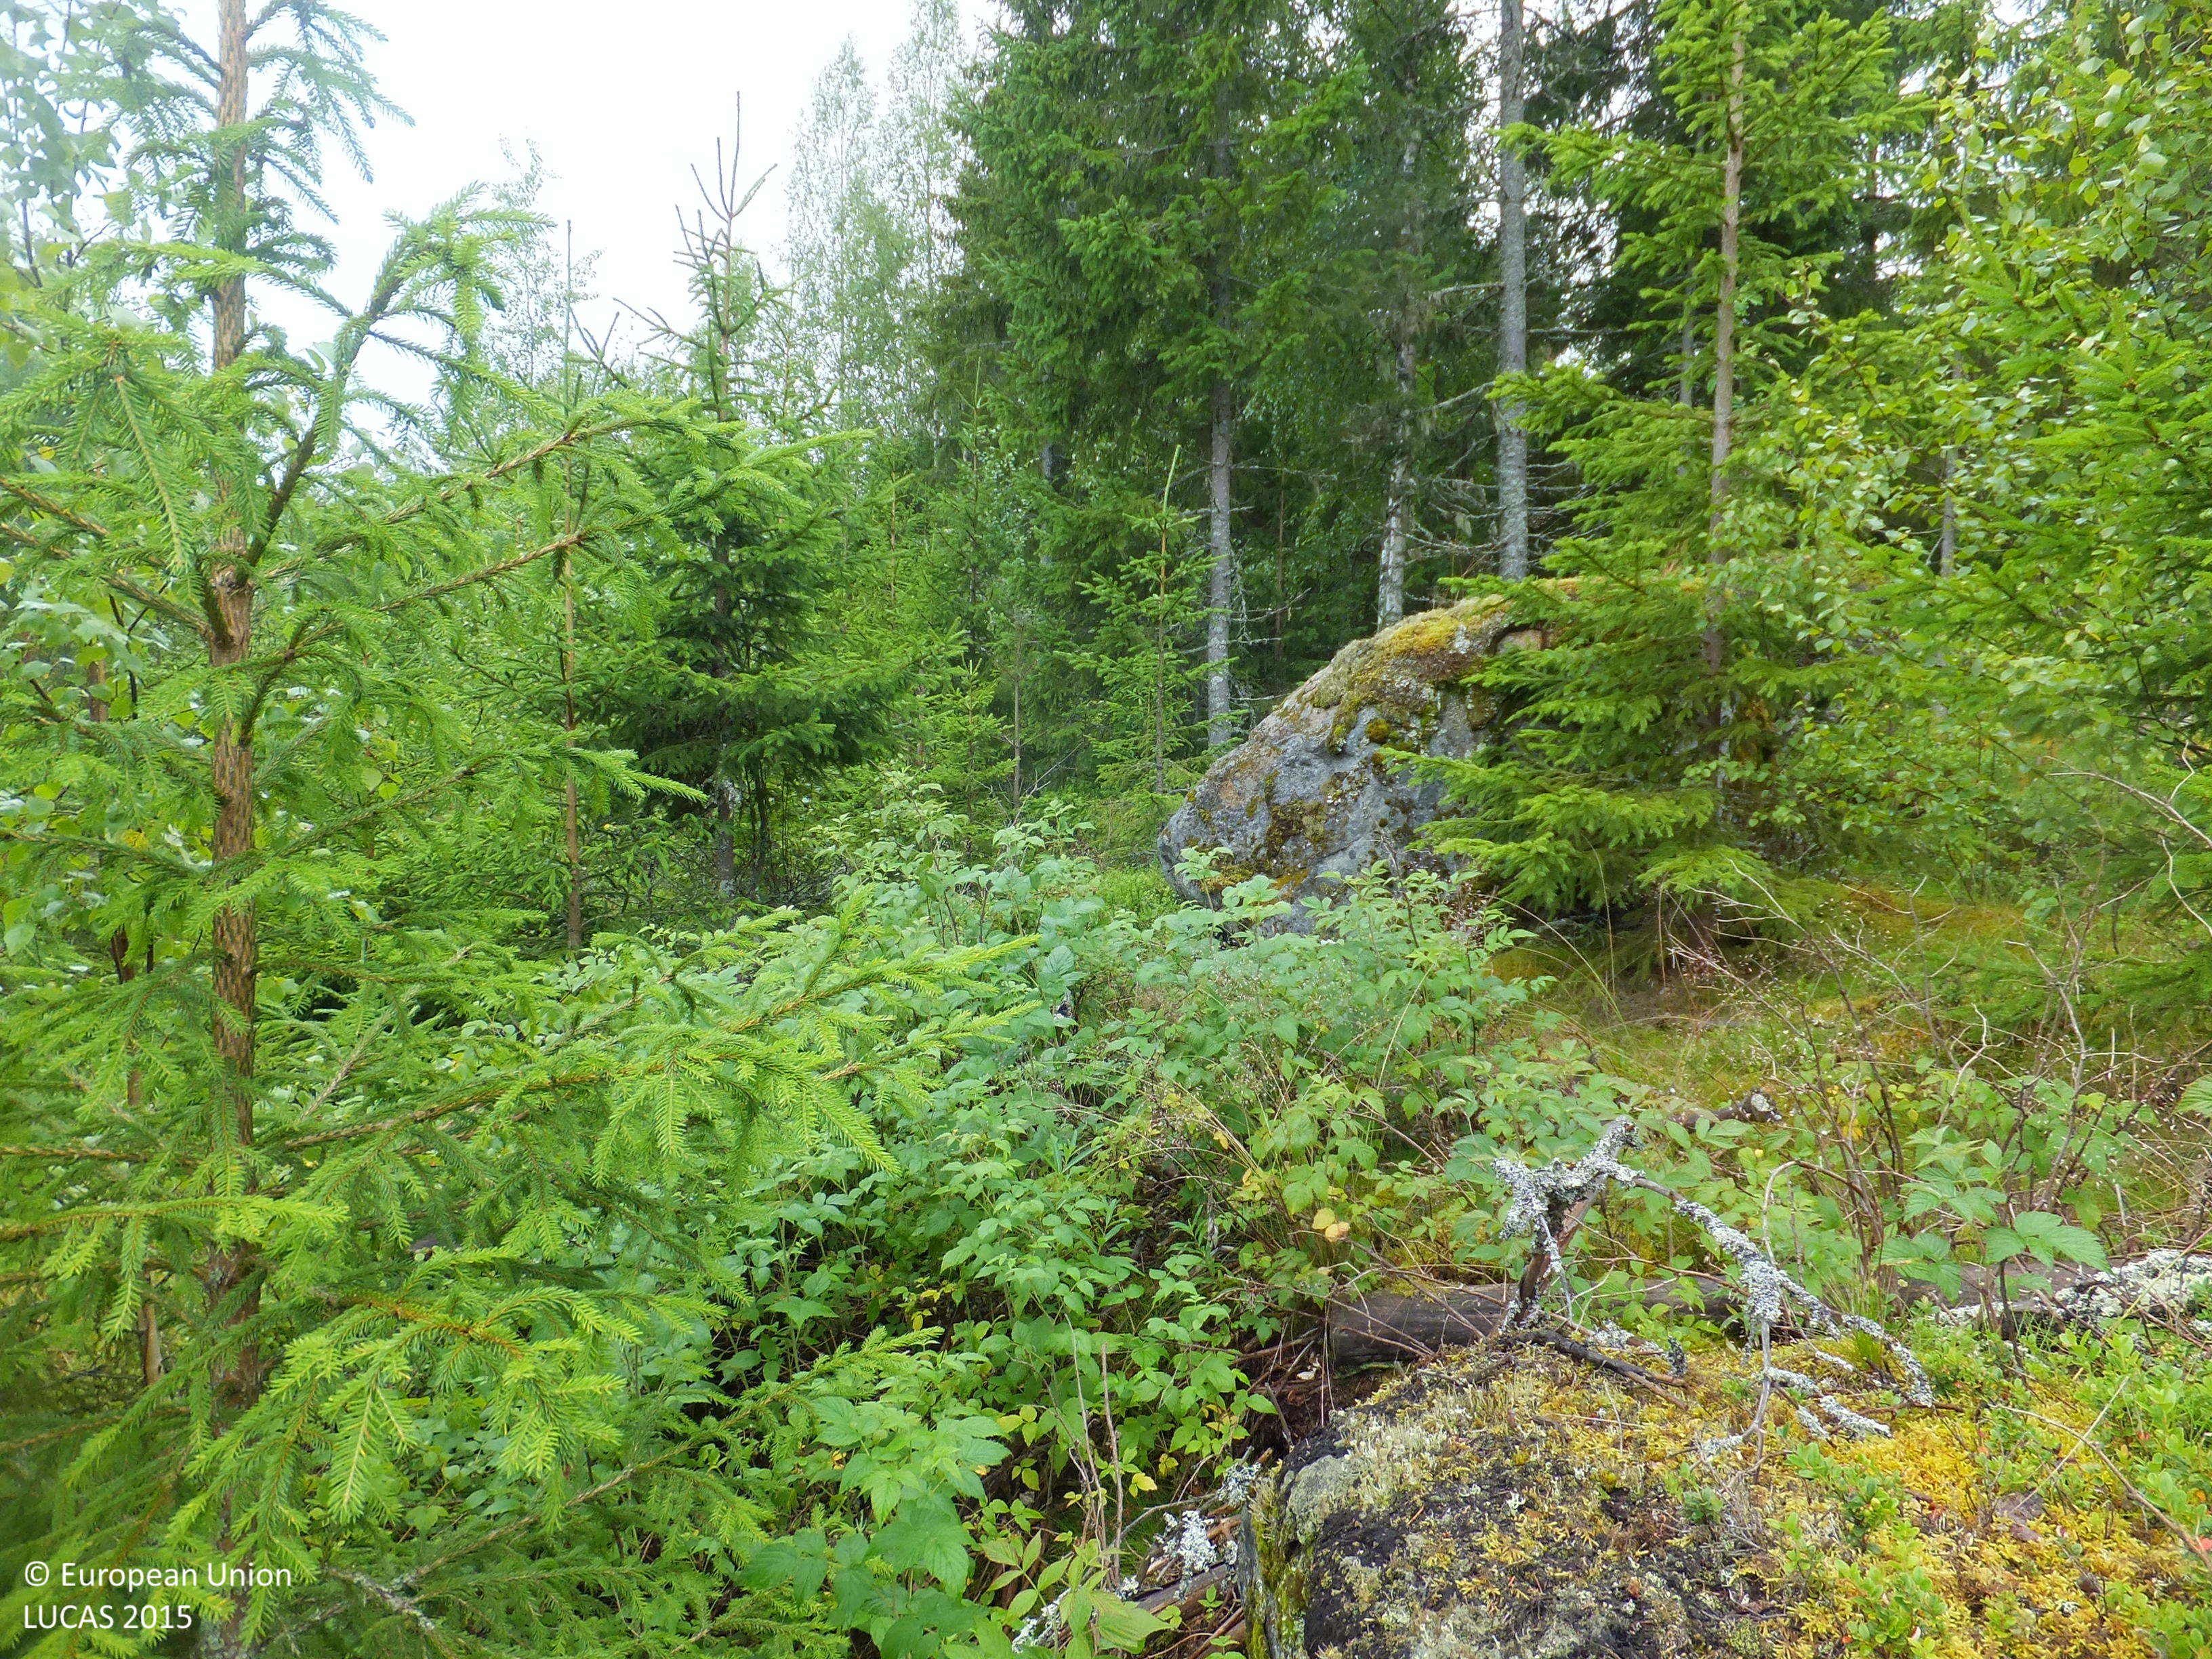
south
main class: Woodland
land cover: Spruce dominated mixed woodland
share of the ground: 10 - 25 %
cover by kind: shrubs 30 %, herbaceous plants 20 %, lichens and mosses 20 %, coniferous forest trees 10 %, broadleaved forest trees 10 %, consolidated bare surface 10 %
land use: Forestry
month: July
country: FI
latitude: 63.0324
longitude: 21.9231
